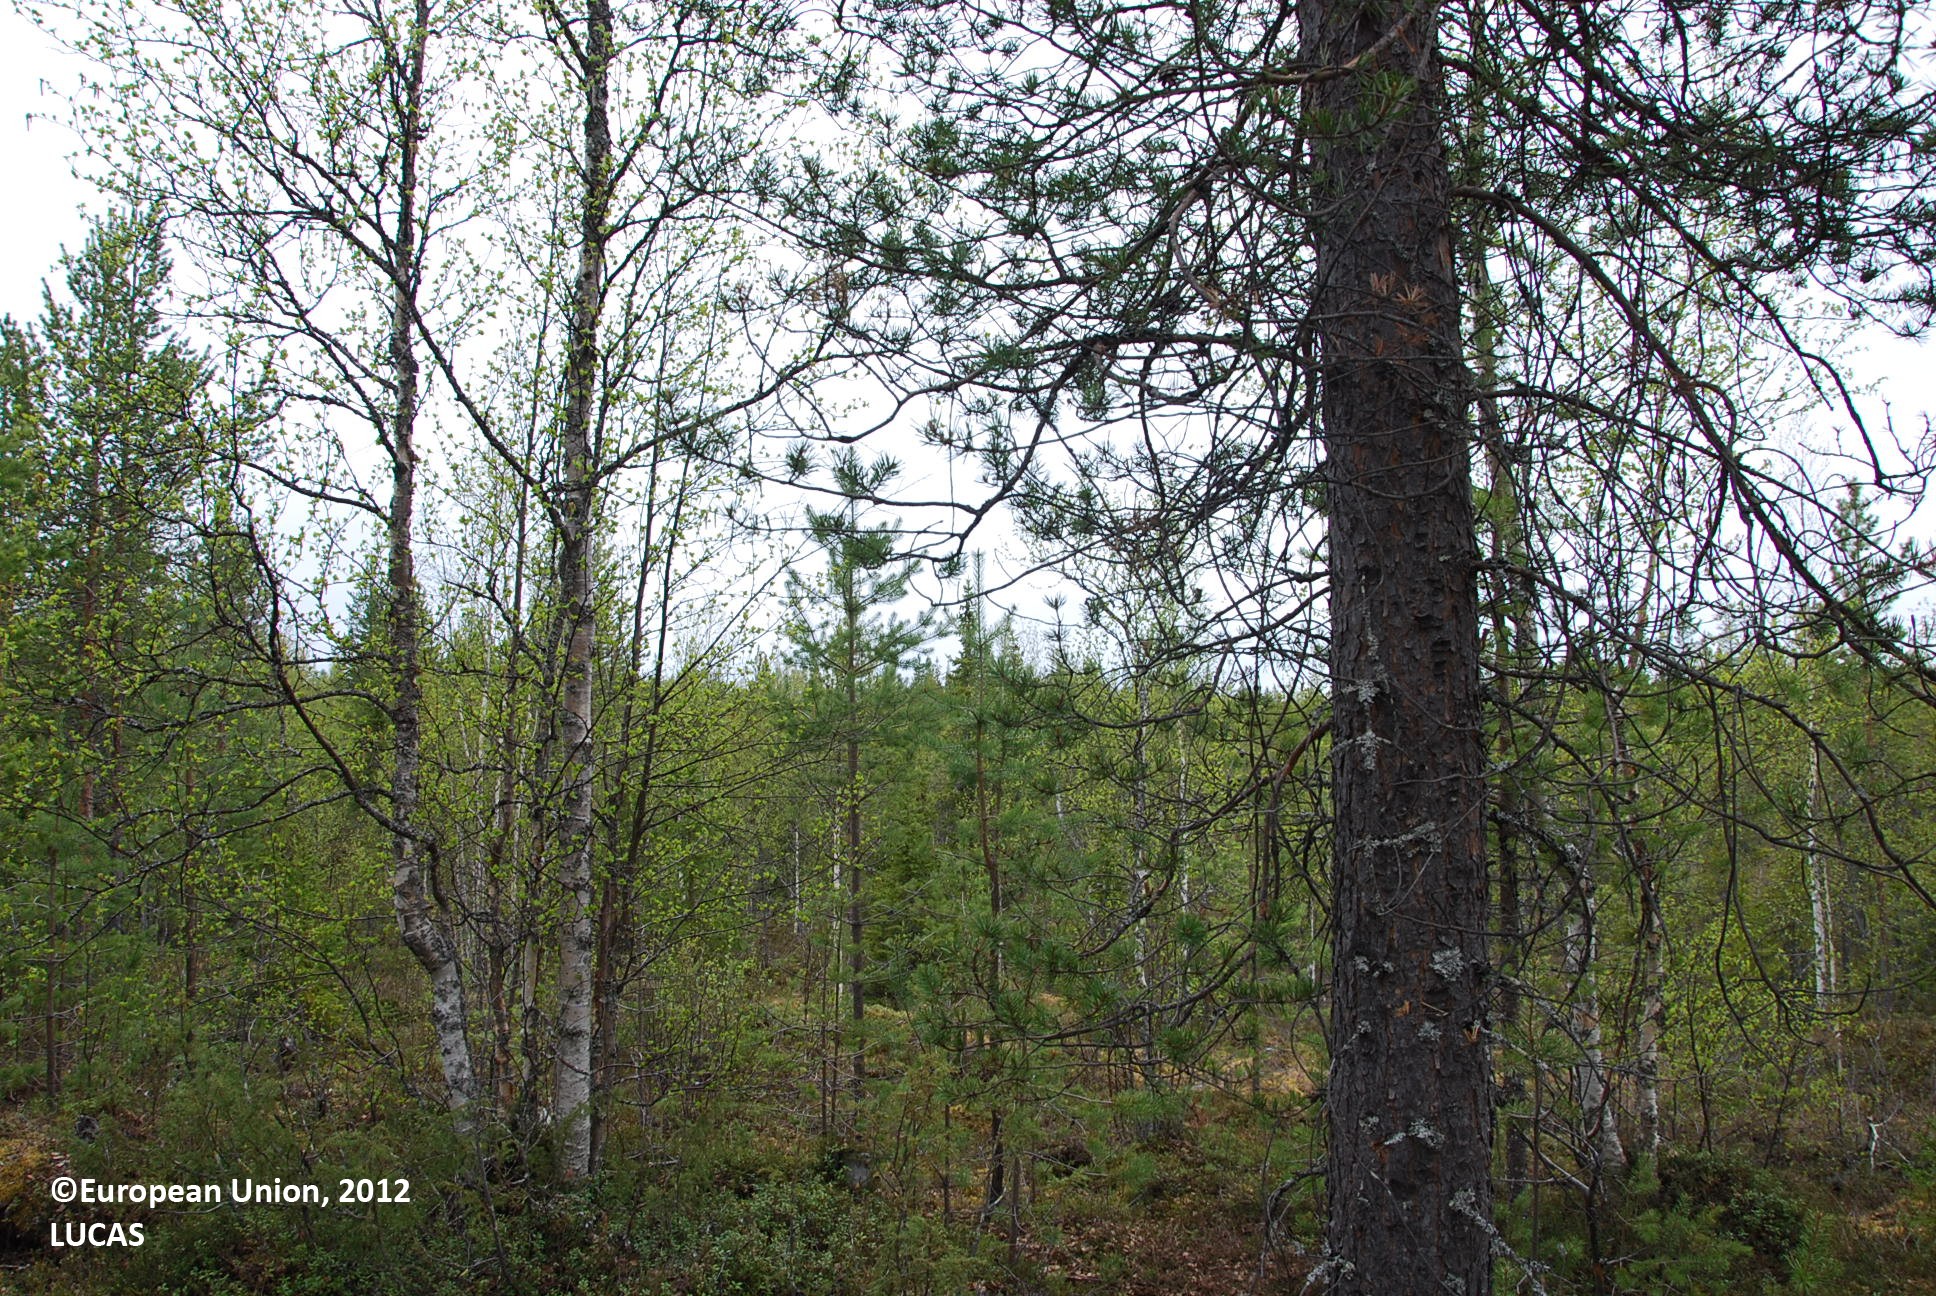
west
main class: Woodland
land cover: Pine dominated coniferous woodland
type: boreal forest
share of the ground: > 75 %
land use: Forestry
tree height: > 5 m
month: June
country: FI
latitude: 66.7874
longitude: 28.2066
